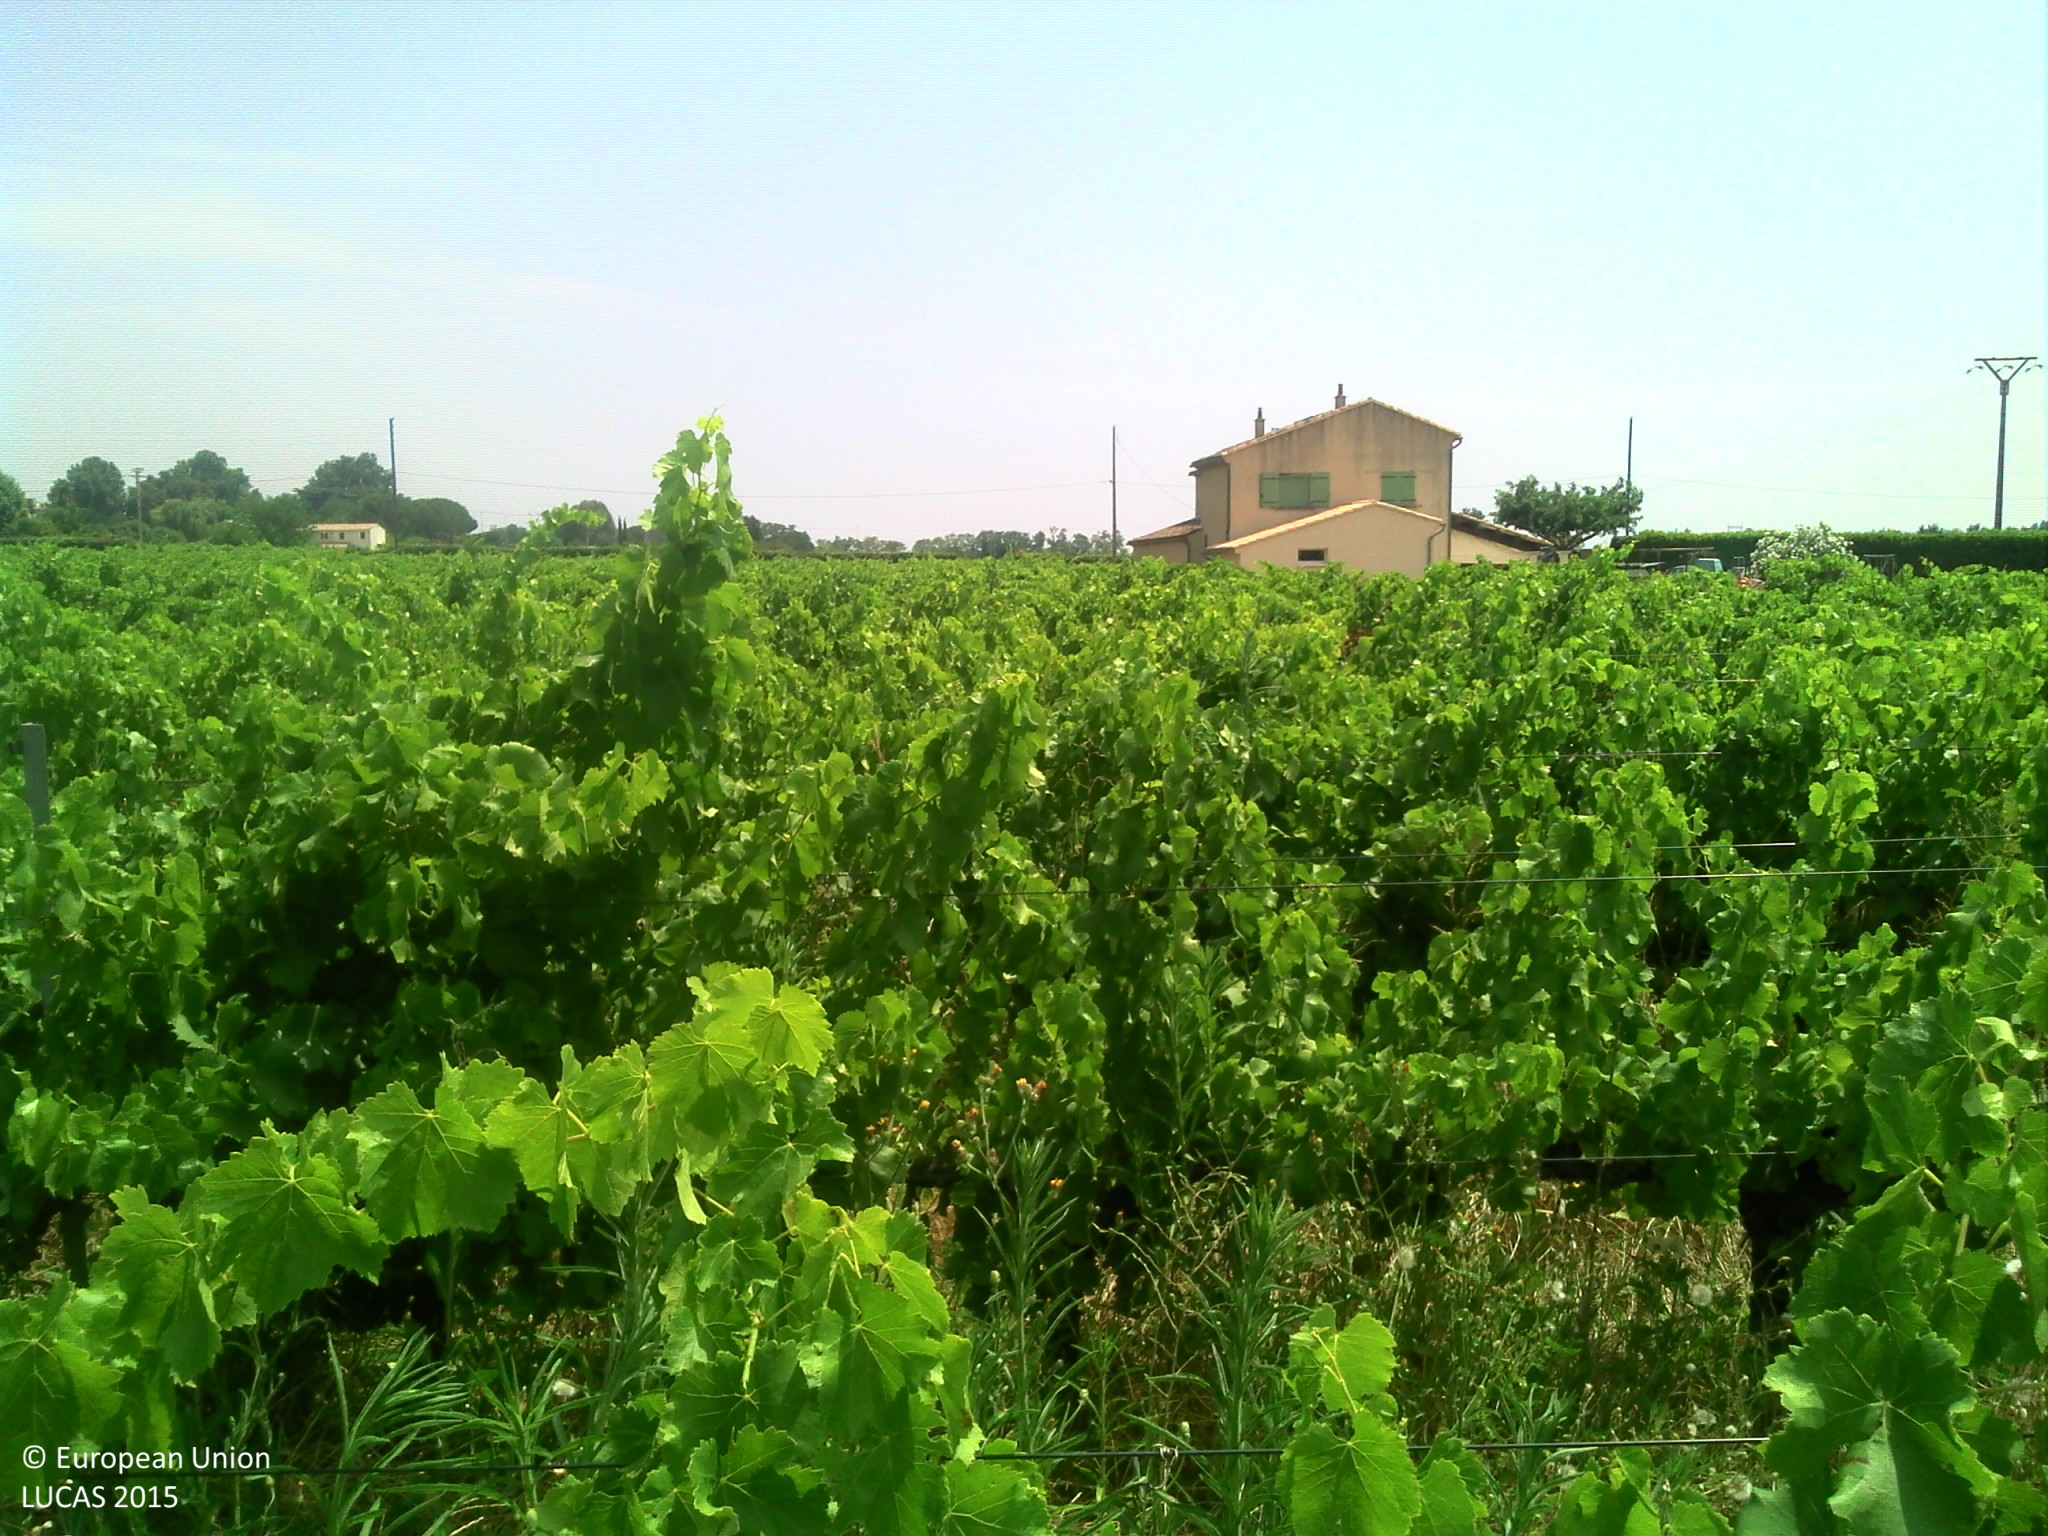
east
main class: Cropland
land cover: Vineyards
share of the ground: 50 - 75 %
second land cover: Grassland without tree/shrub cover
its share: 50 - 75 %
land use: Agriculture (excluding fallow land and kitchen gardens)
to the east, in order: Vineyards; Grassland without tree/shrub cover; Grass margins; Electric lines; Paved roads, cycling and walking lanes; Dry stone walls; Grassland without tree/shrub cover; Vineyards; Tracks; Vineyards
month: July
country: FR
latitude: 44.3006
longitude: 4.6051
